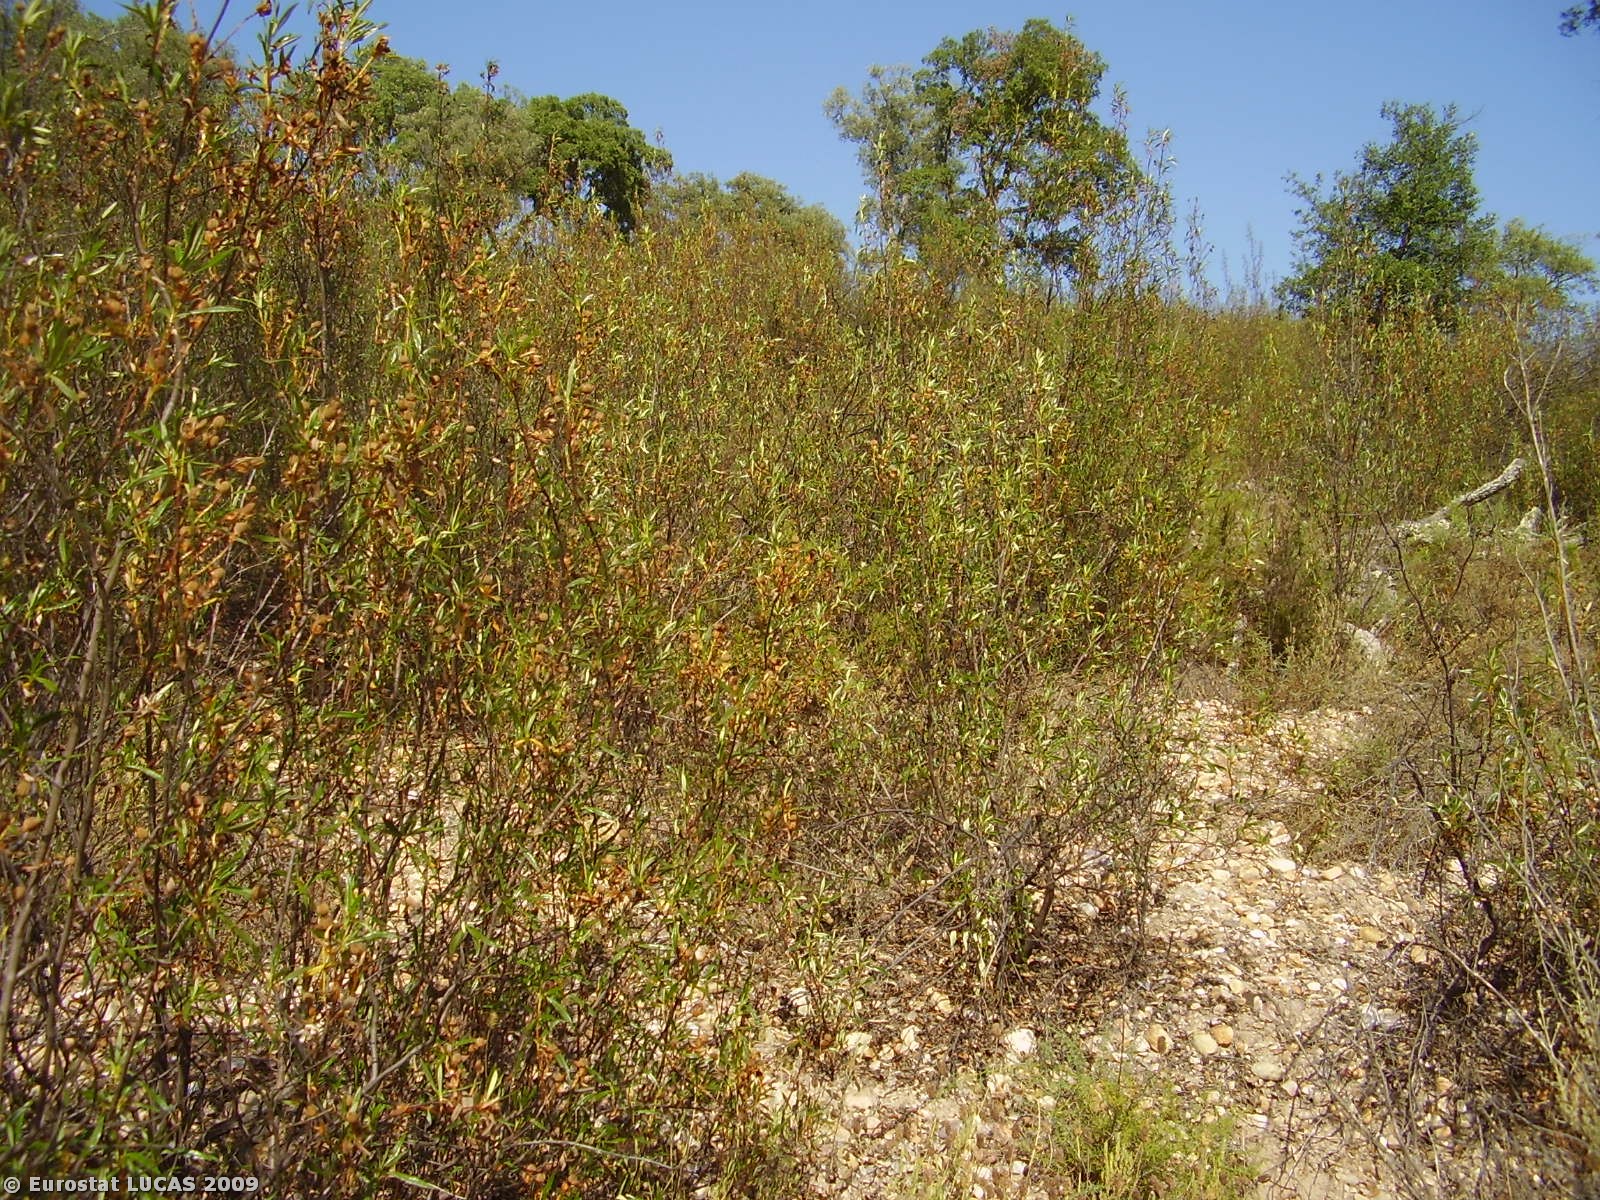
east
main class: Woodland
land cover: Broadleaved woodland
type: broadleaved evergreen forest
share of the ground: 10 - 25 %
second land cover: Shrubland with sparse tree cover
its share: > 75 %
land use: Forestry
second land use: Fallow land
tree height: > 5 m
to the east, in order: Broadleaved woodland; Shrubland with sparse tree cover; Broadleaved woodland; Tracks; Broadleaved woodland; Mixed woodland; Tracks; Coniferous woodland
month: July
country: PT
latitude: 39.4095
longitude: -8.0488
